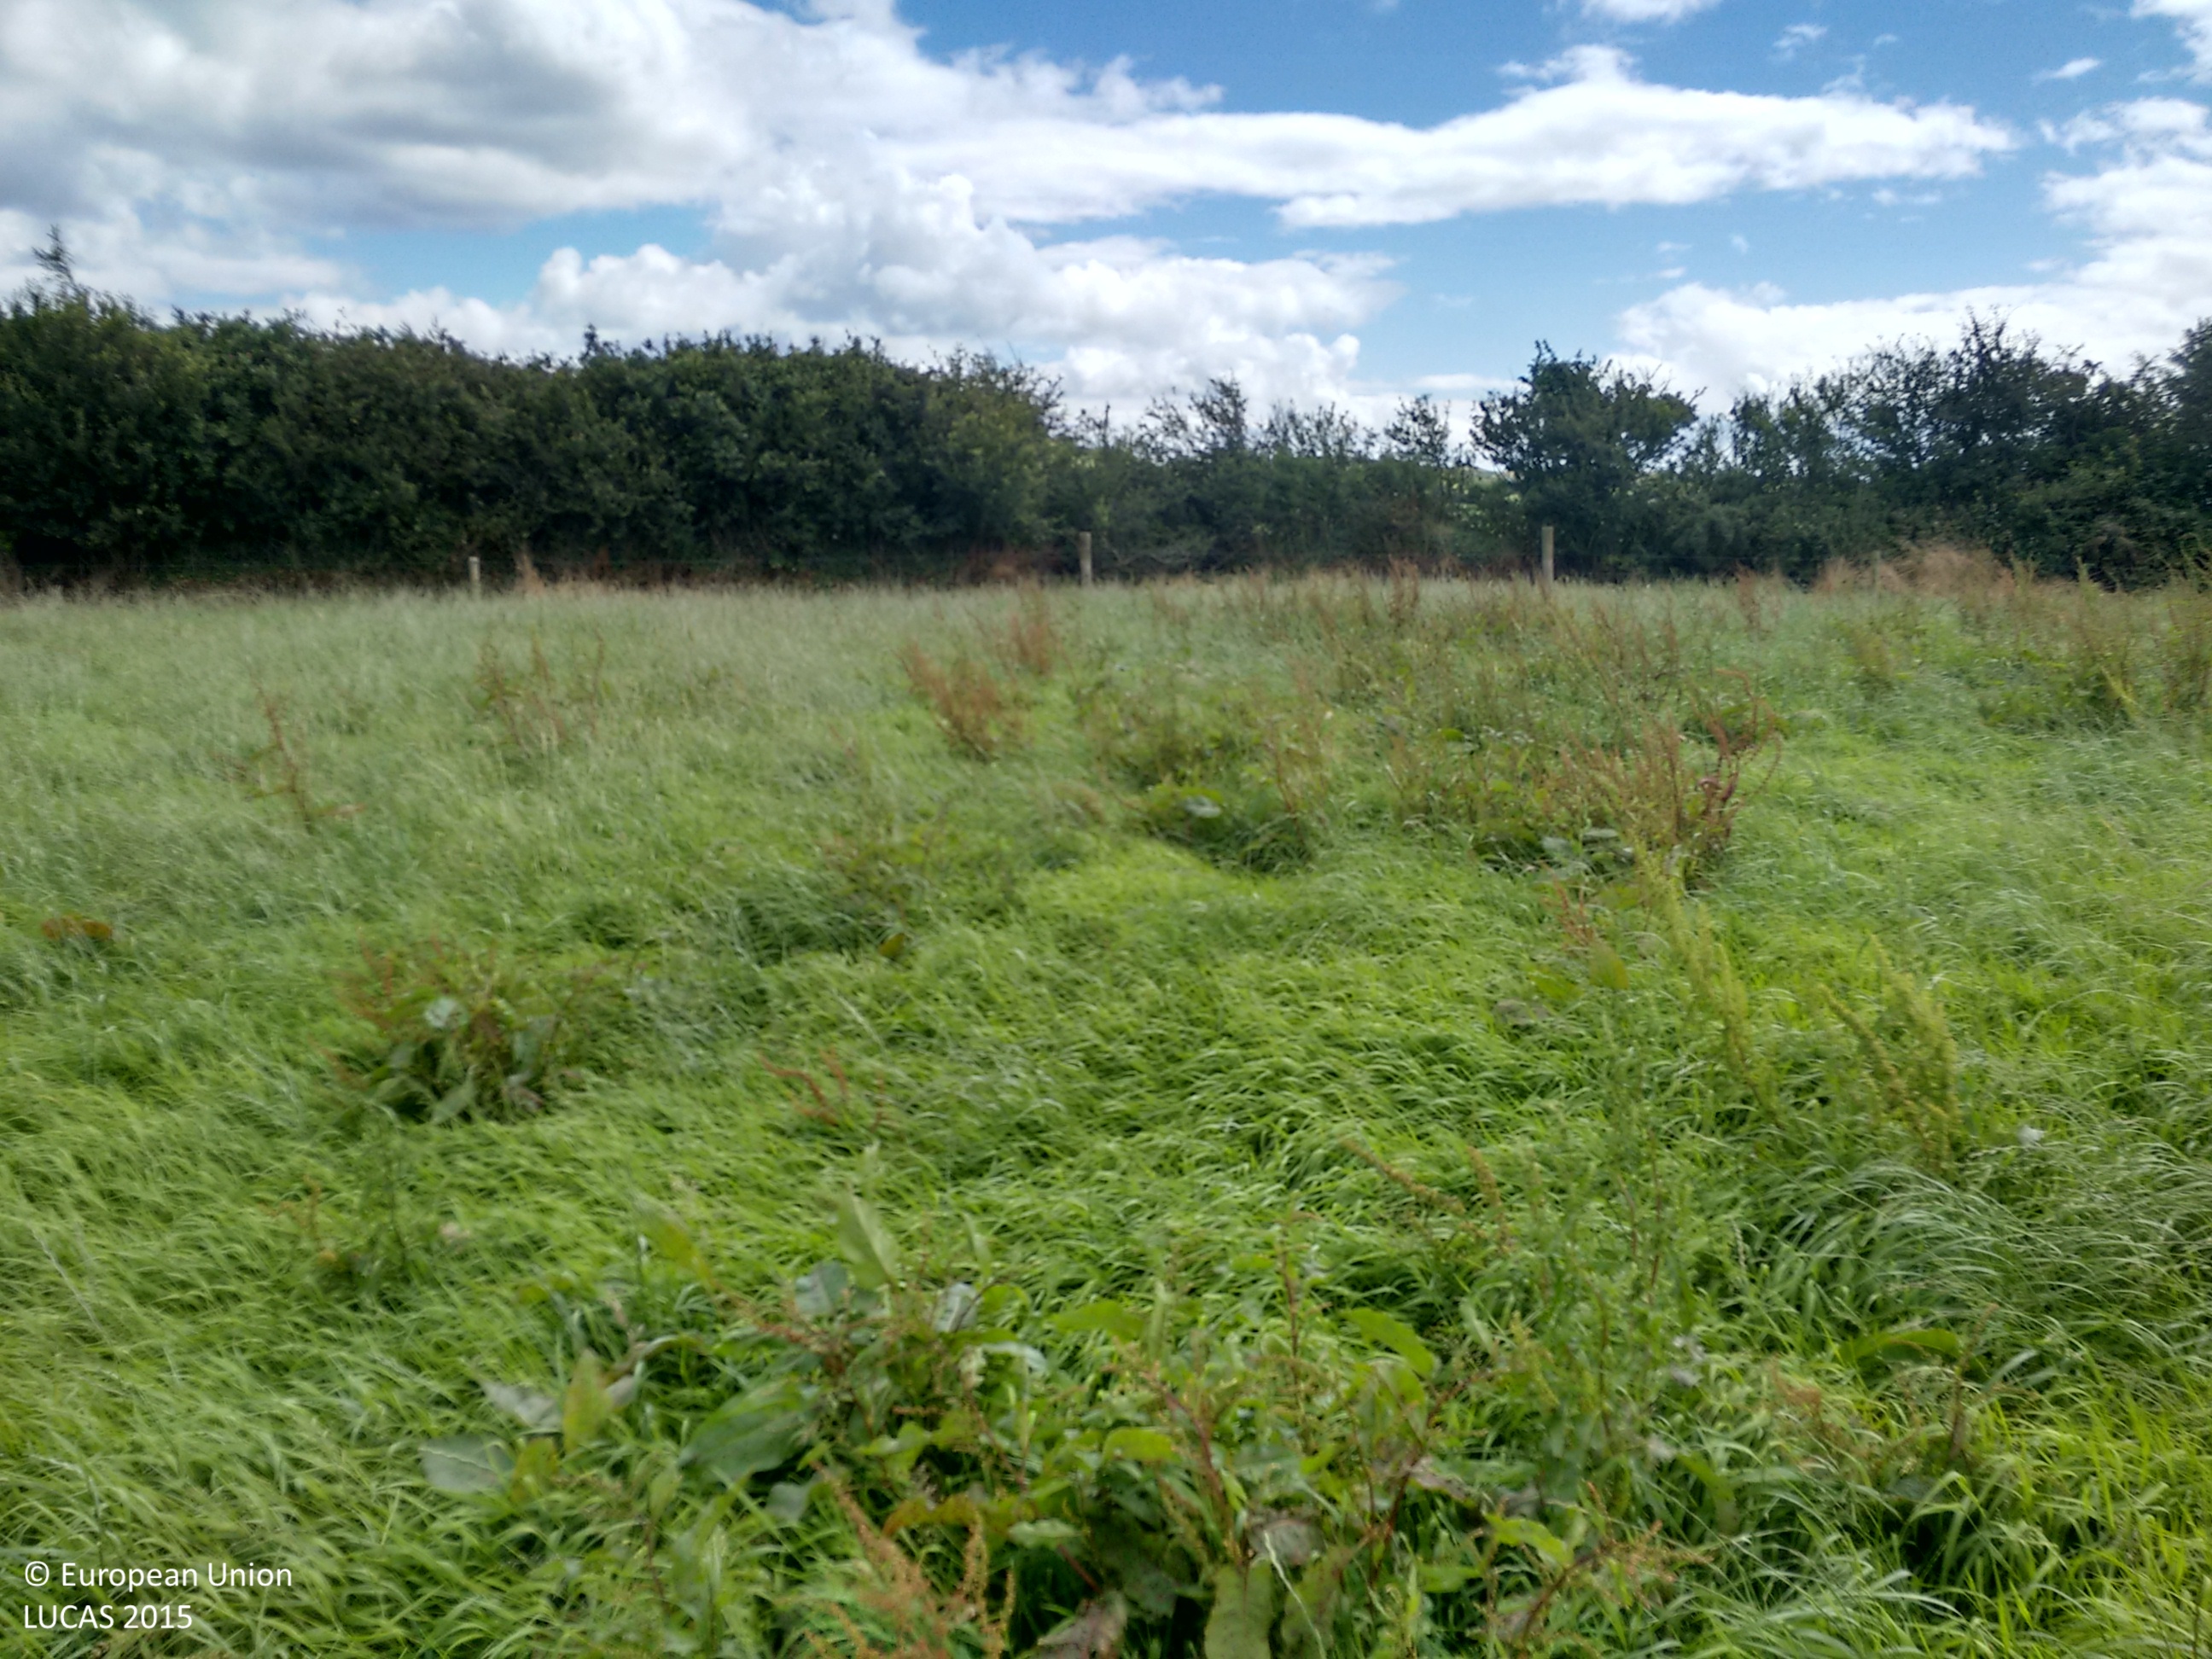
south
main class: Grassland
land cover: Grassland without tree/shrub cover
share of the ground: > 75 %
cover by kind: herbaceous plants 100 %
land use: Agriculture (excluding fallow land and kitchen gardens)
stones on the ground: < 10 %
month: July
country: IE
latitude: 51.5306
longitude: -9.2957
